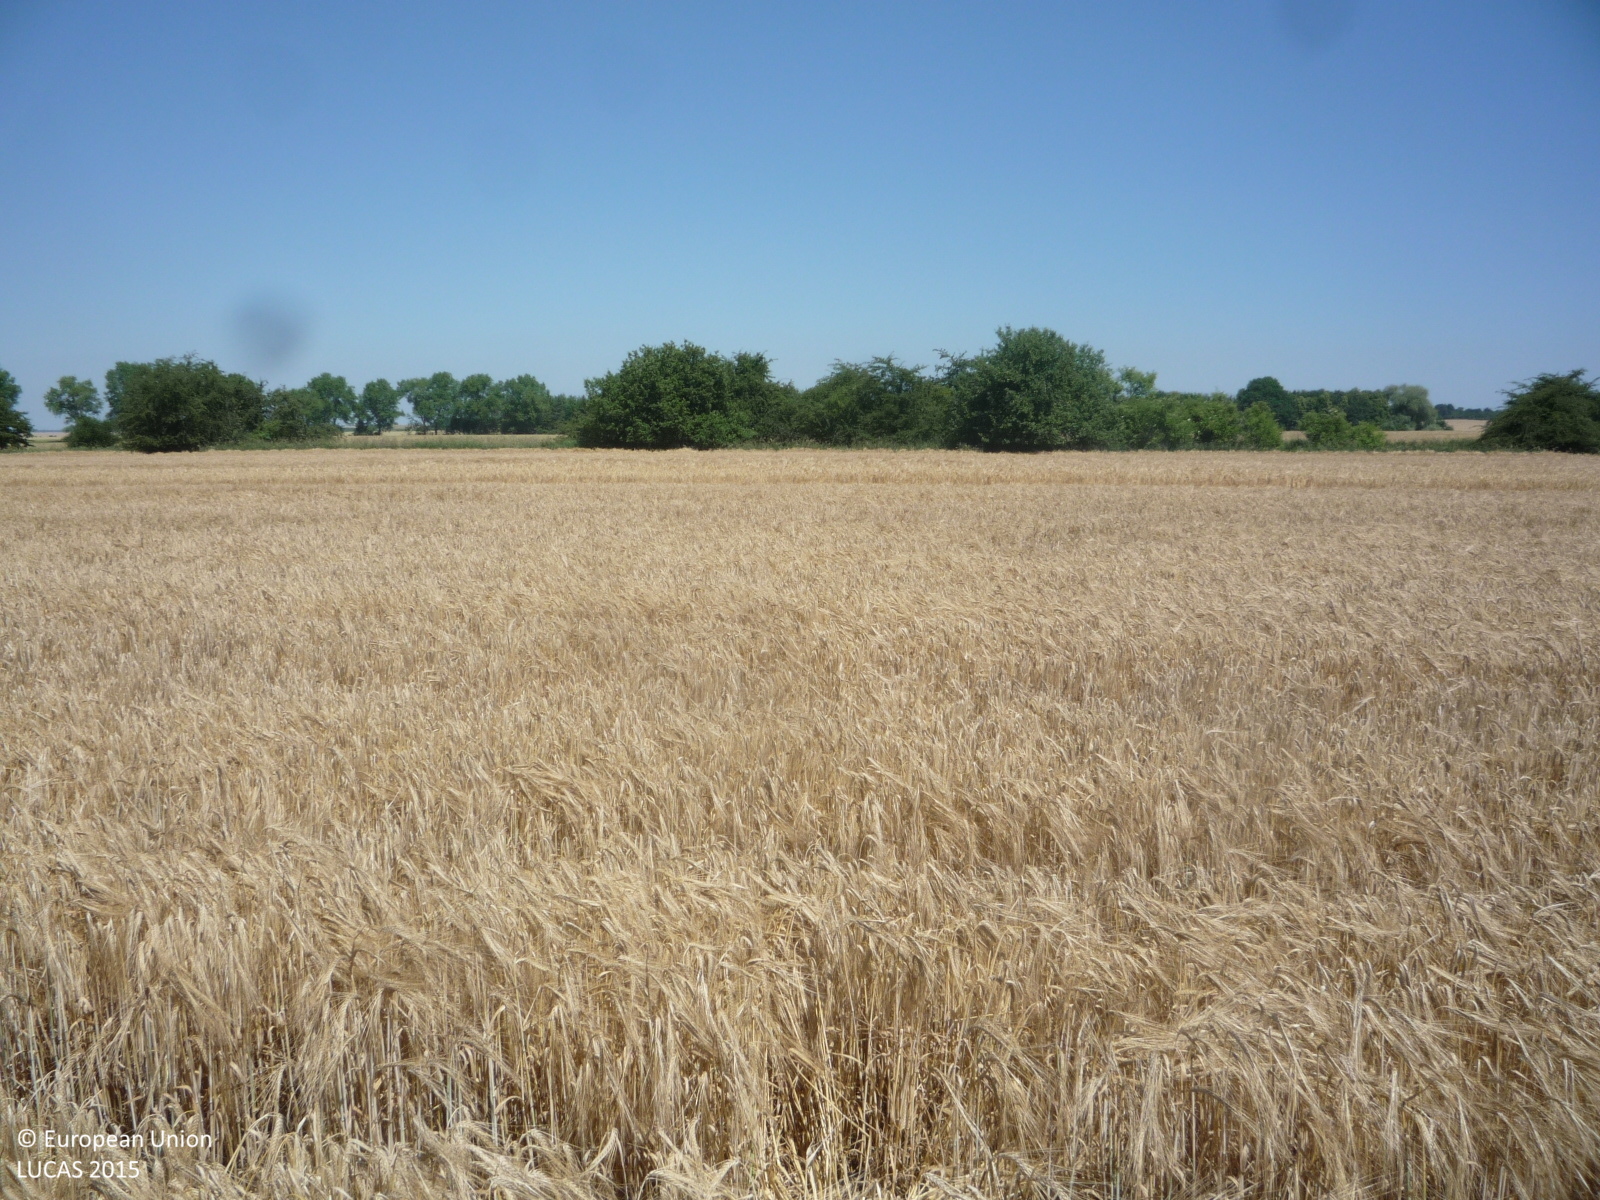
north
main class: Cropland
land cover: Barley
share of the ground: > 75 %
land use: Agriculture (excluding fallow land and kitchen gardens)
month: July
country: CZ
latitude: 50.2289
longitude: 15.1759
